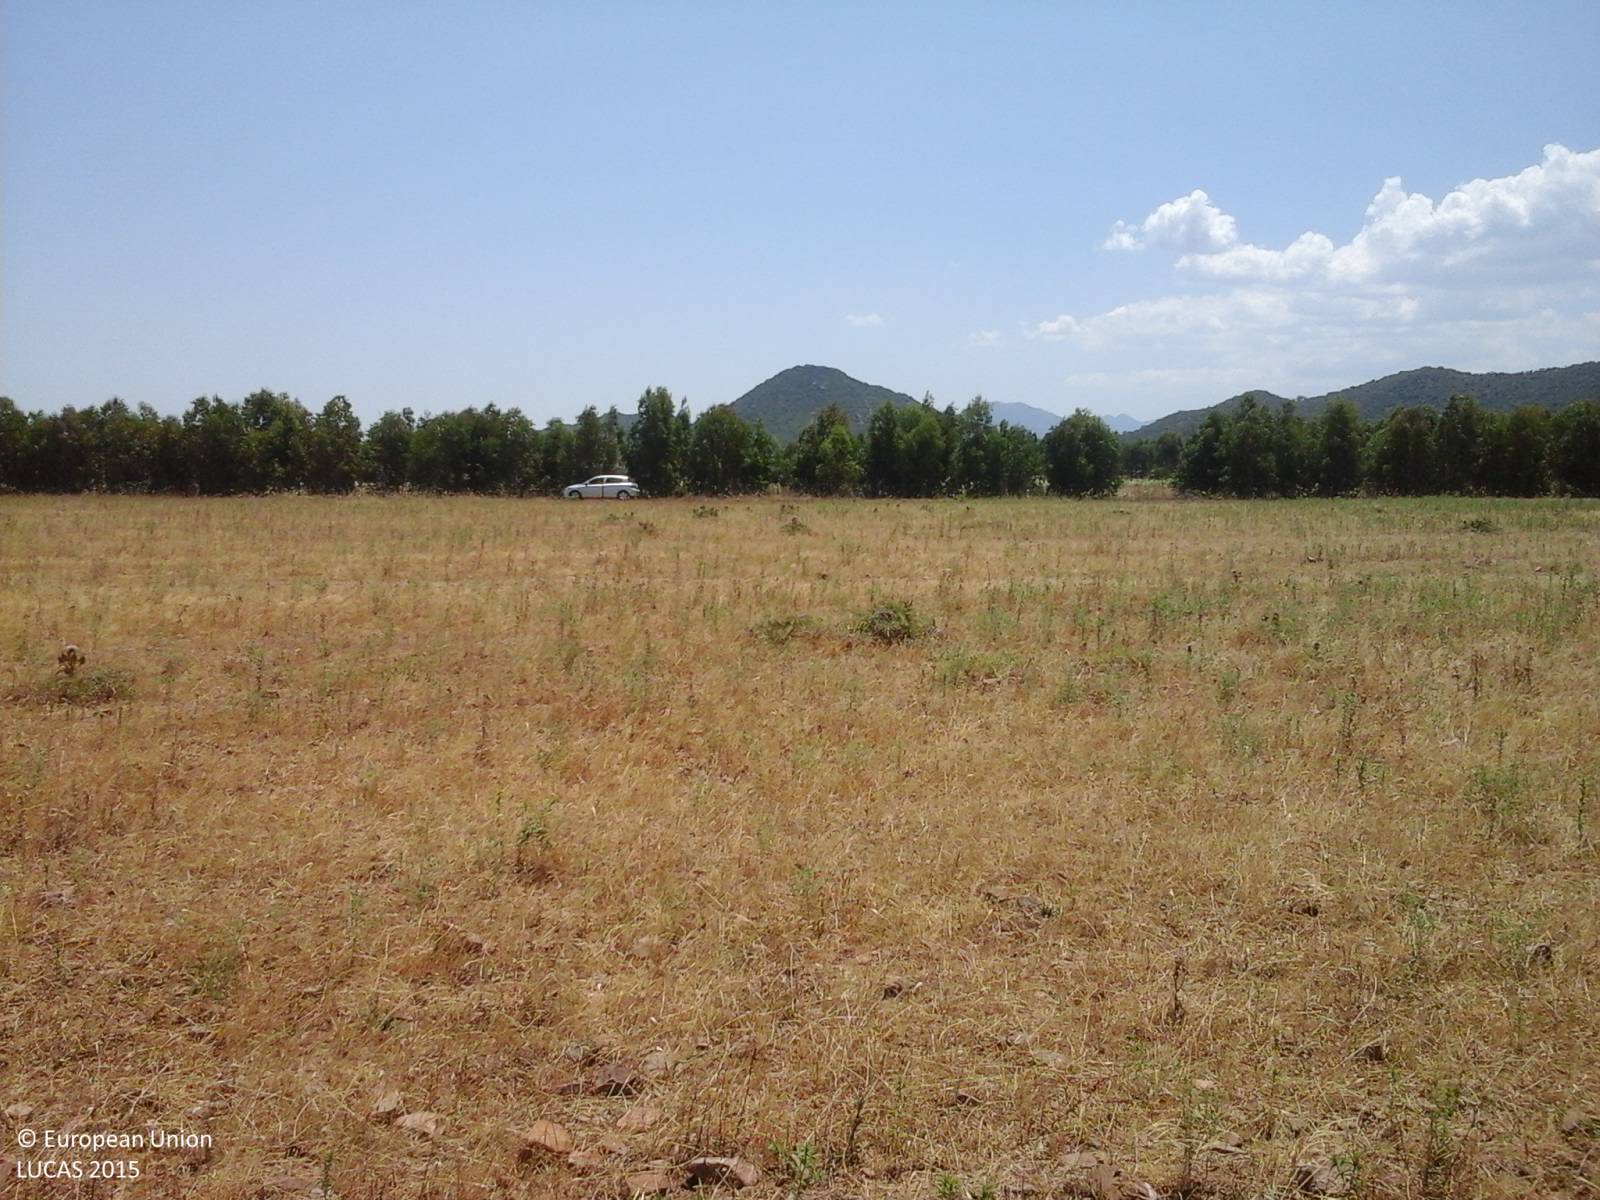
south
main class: Grassland
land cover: Spontaneously vegetated surfaces
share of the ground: > 75 %
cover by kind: herbaceous plants 85 %, unconsolidated bare surface 15 %
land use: Agriculture (excluding fallow land and kitchen gardens)
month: June
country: IT
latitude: 39.3369
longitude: 8.8584
